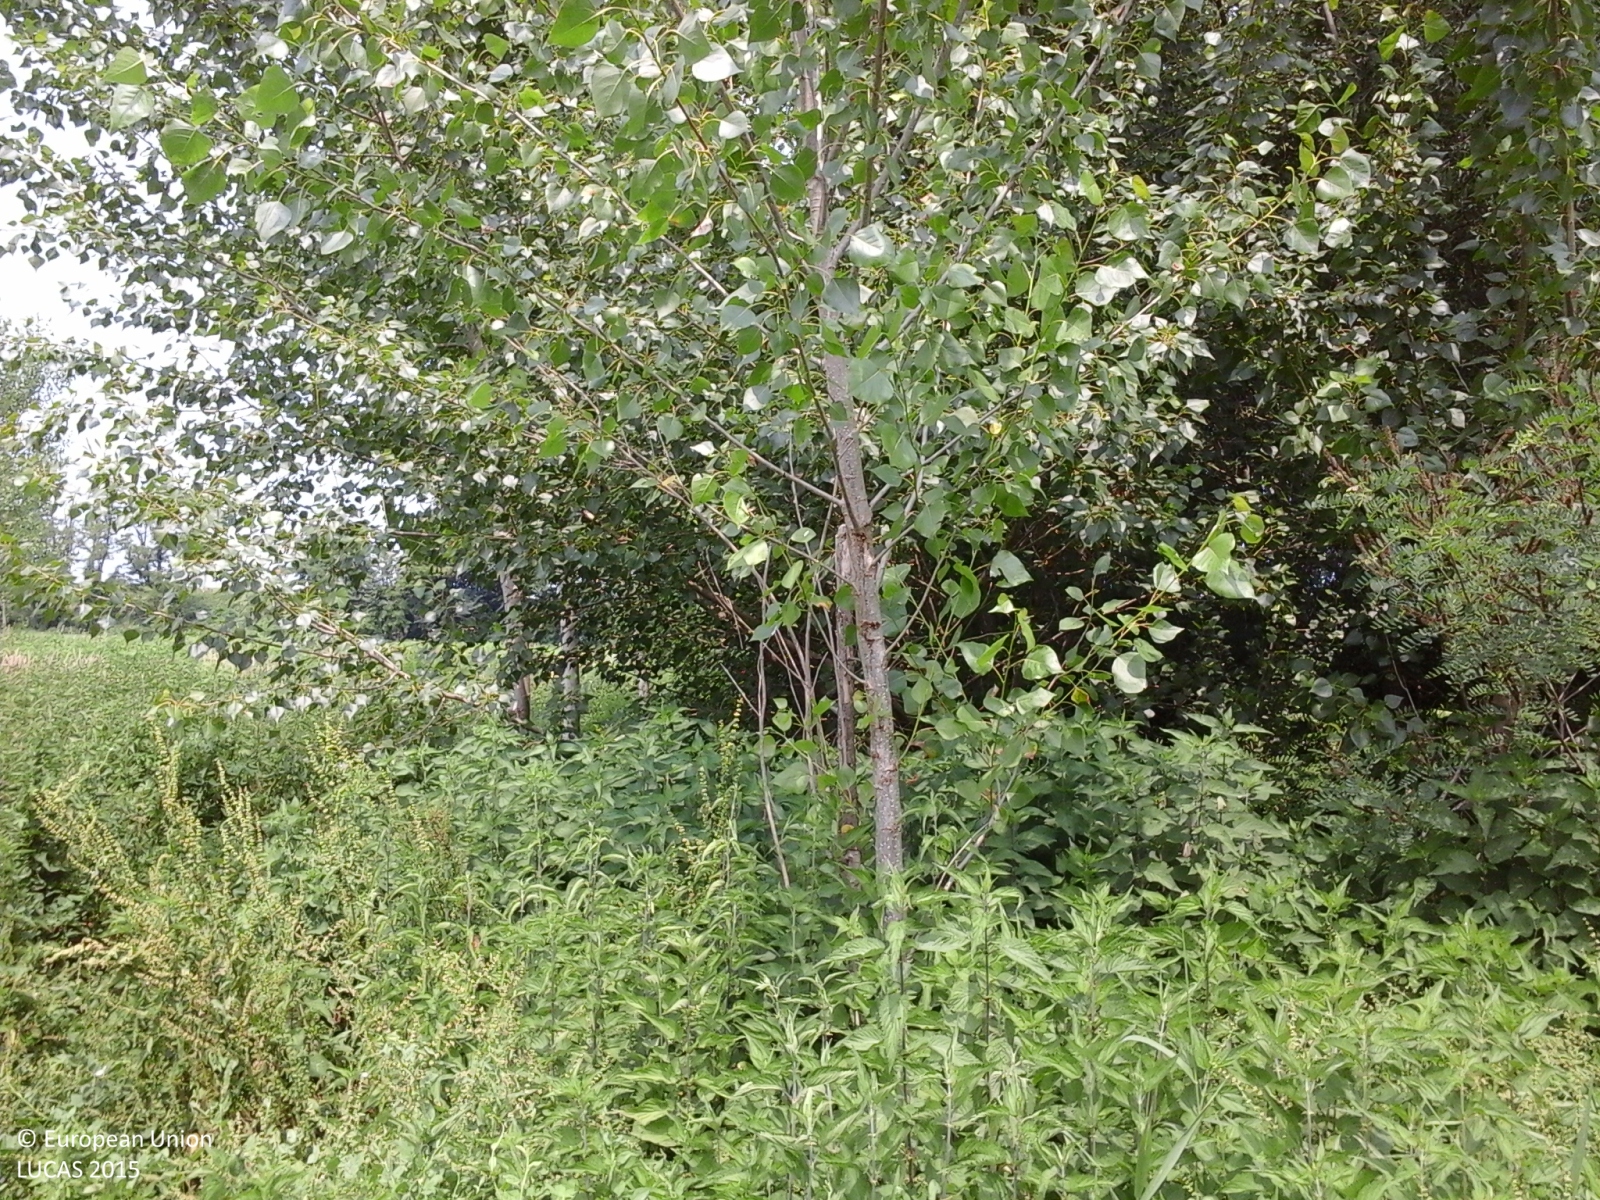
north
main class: Woodland
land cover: Broadleaved woodland
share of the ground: > 75 %
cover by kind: broadleaved forest trees 100 %
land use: Forestry
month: June
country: IT
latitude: 45.0538
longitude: 10.0634
